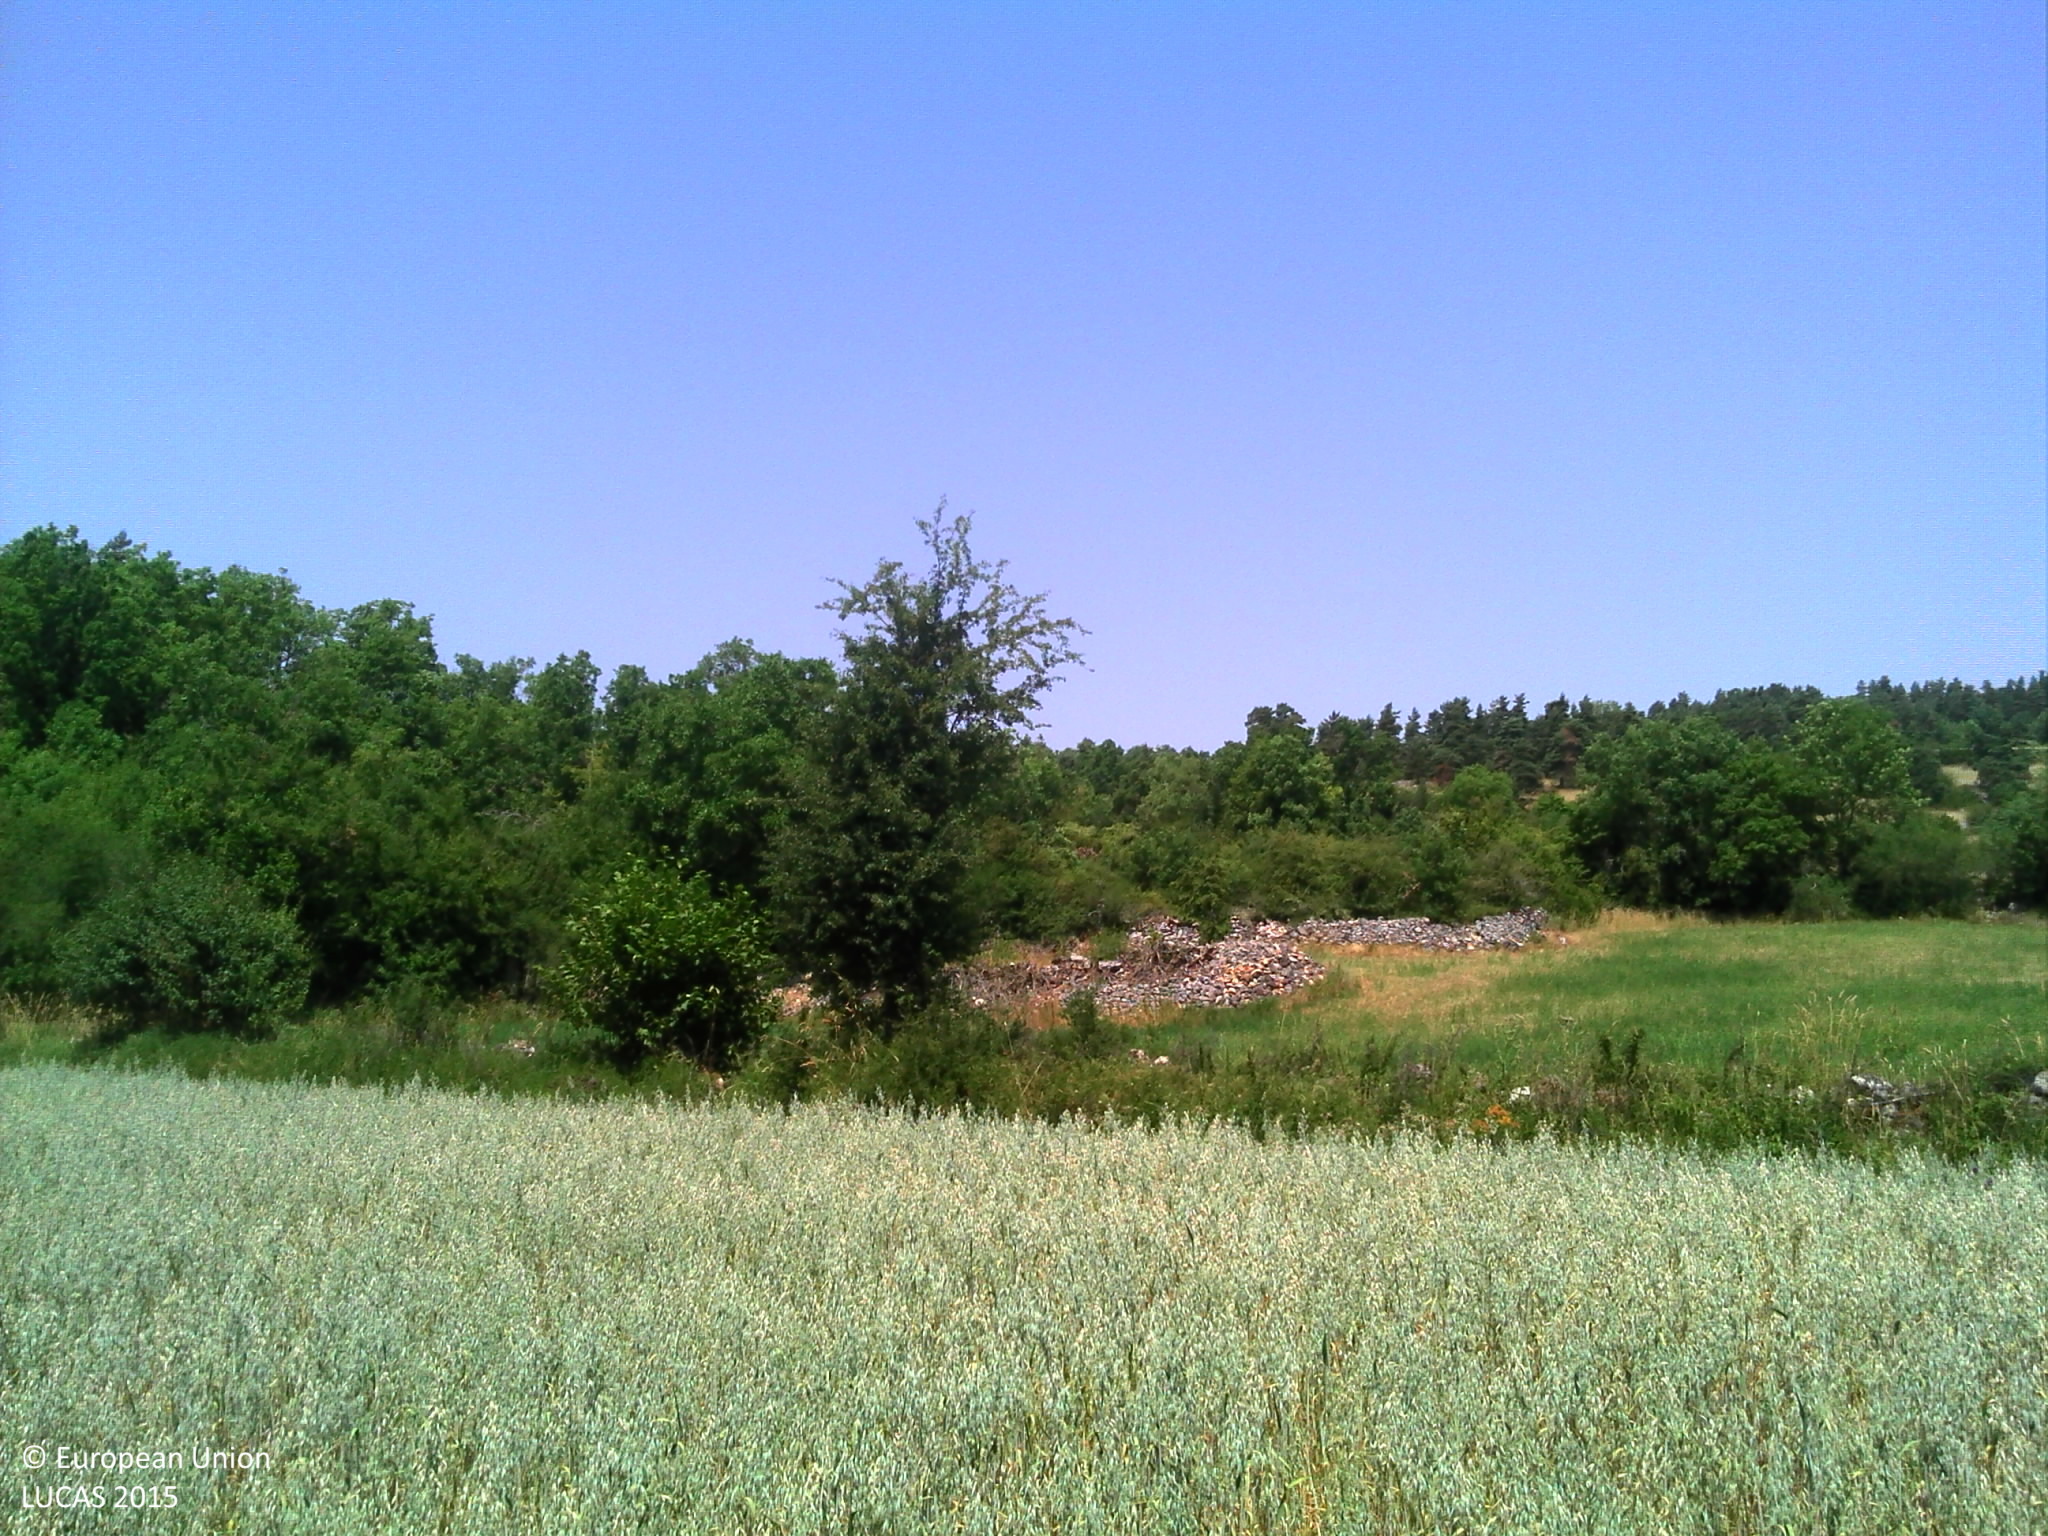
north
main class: Cropland
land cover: Oats
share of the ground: > 75 %
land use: Agriculture (excluding fallow land and kitchen gardens)
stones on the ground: 25 - 50 %
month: July
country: FR
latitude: 44.3131
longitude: 3.2731
